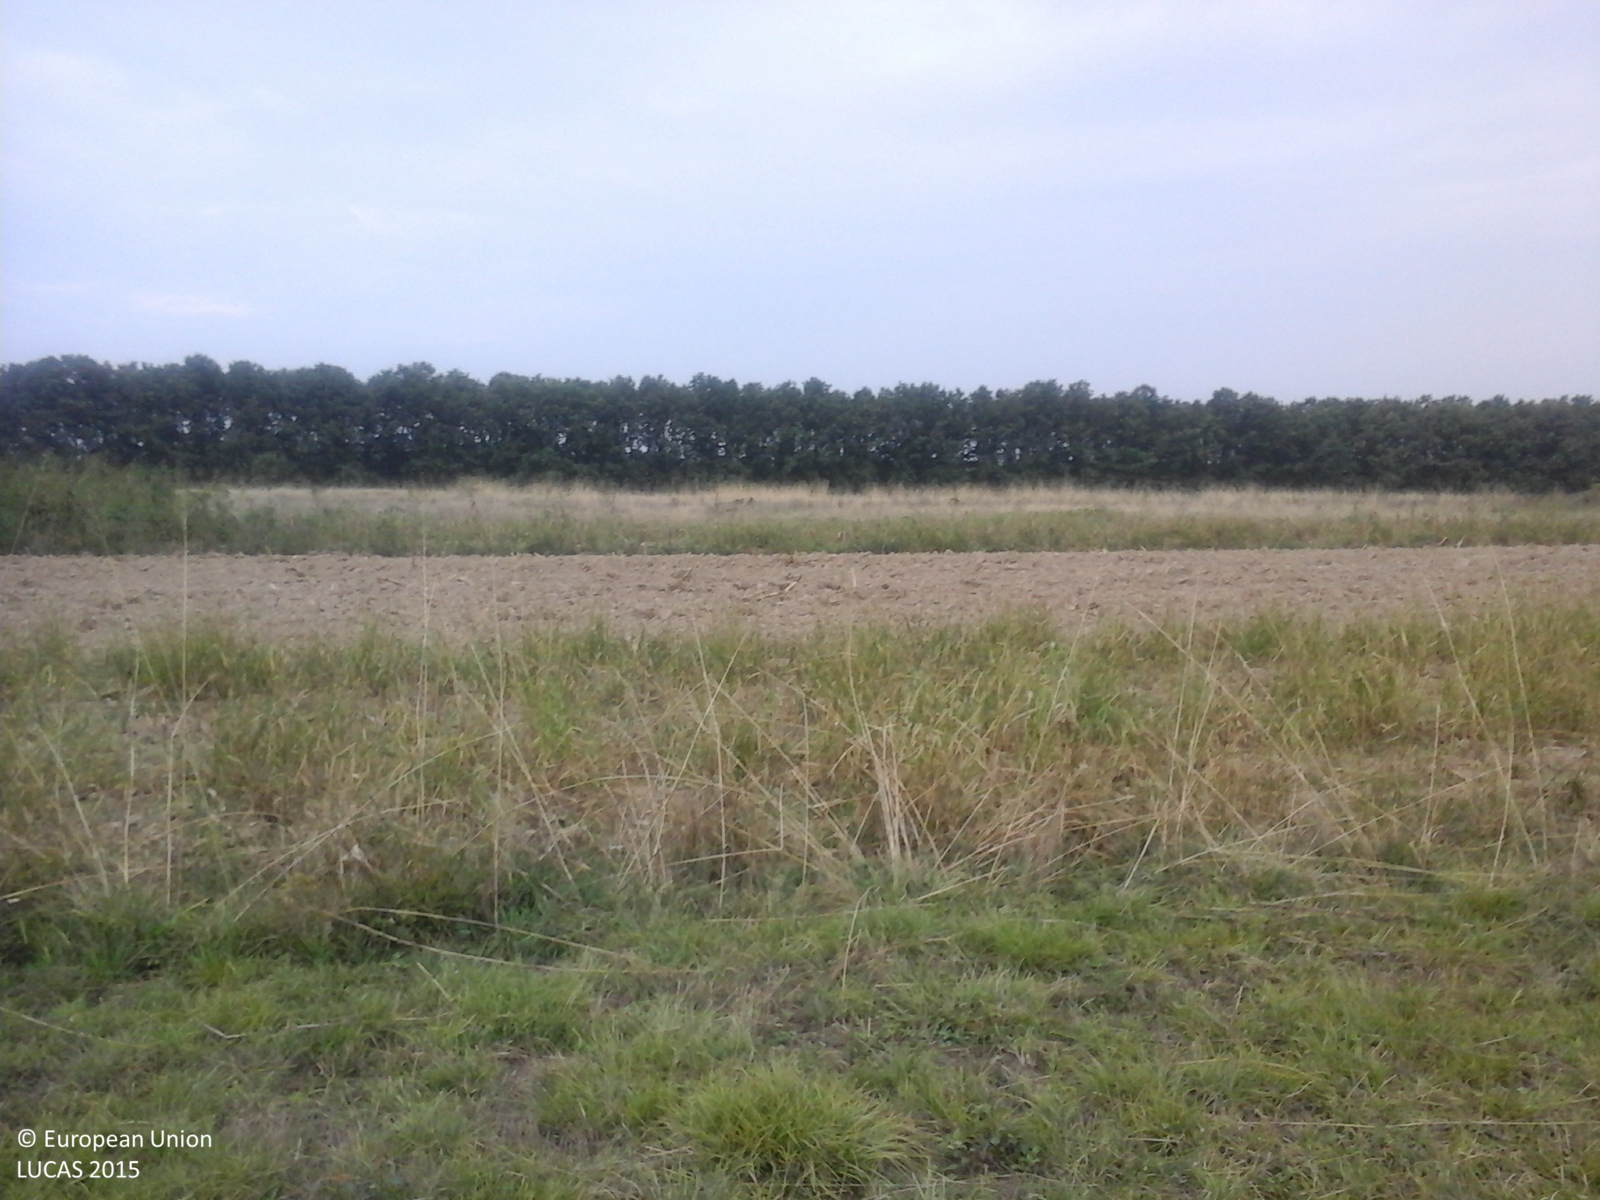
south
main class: Grassland
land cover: Grassland without tree/shrub cover
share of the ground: > 75 %
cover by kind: herbaceous plants 100 %
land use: Agriculture (excluding fallow land and kitchen gardens)
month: September
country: RO
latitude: 44.9556
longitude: 23.4033
